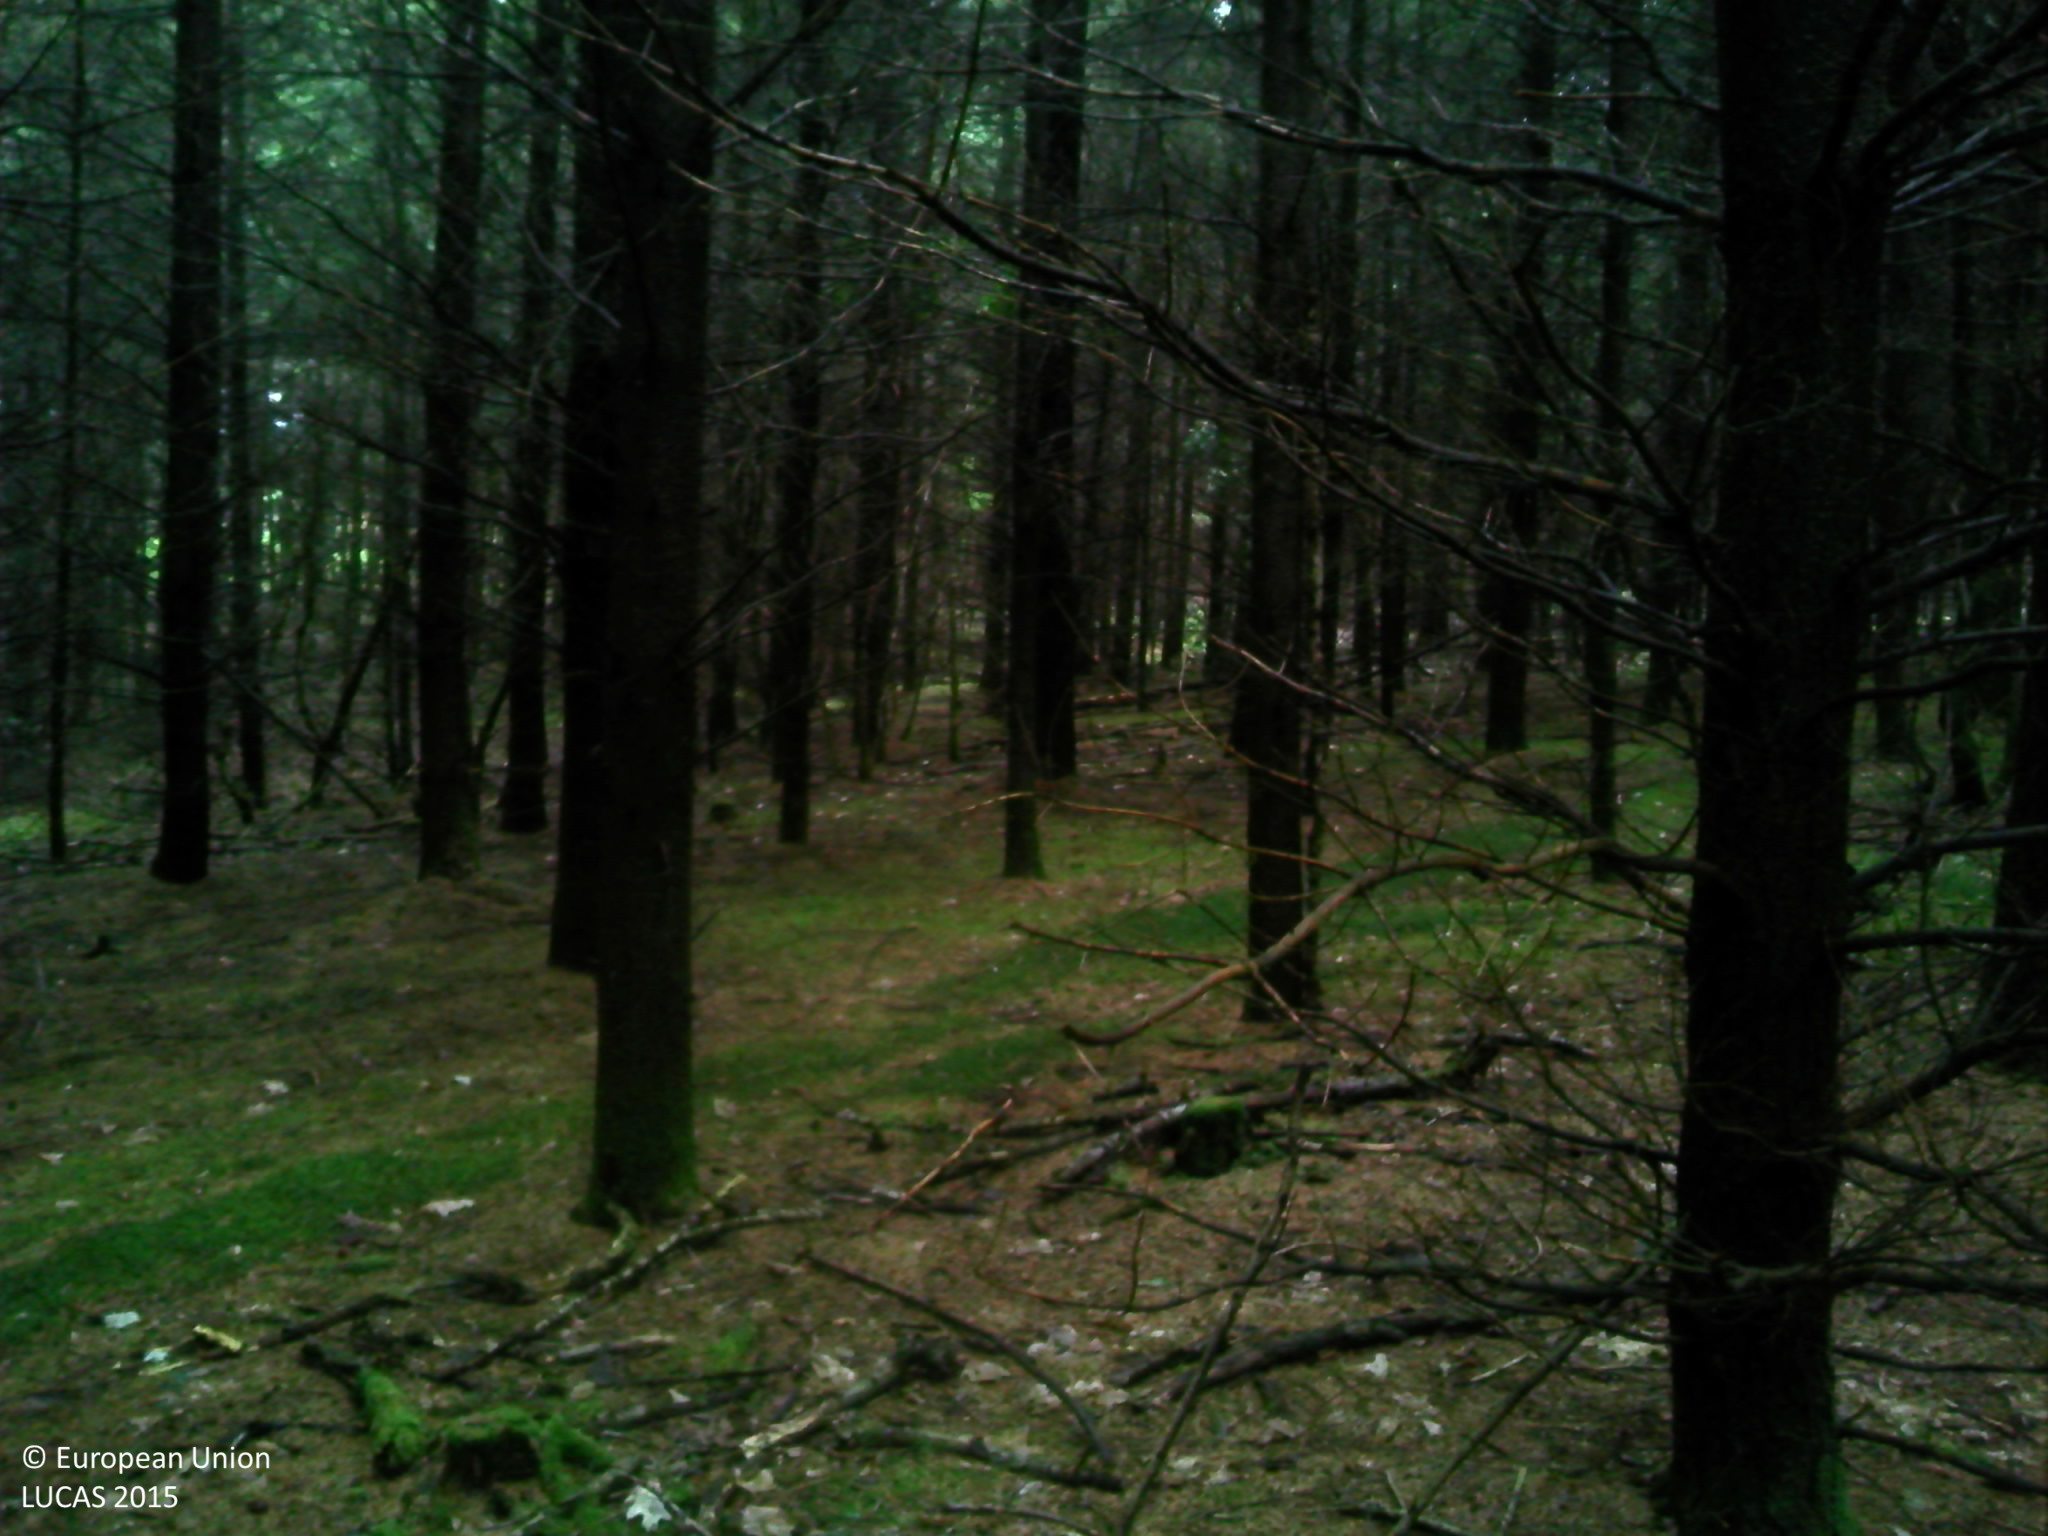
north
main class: Woodland
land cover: Other coniferous woodland
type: exotic forest
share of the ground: > 75 %
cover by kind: coniferous forest trees 90 %, herbaceous plants 10 %
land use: Forestry
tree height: > 5 m
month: July
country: FR
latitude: 46.4800
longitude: 4.4916
